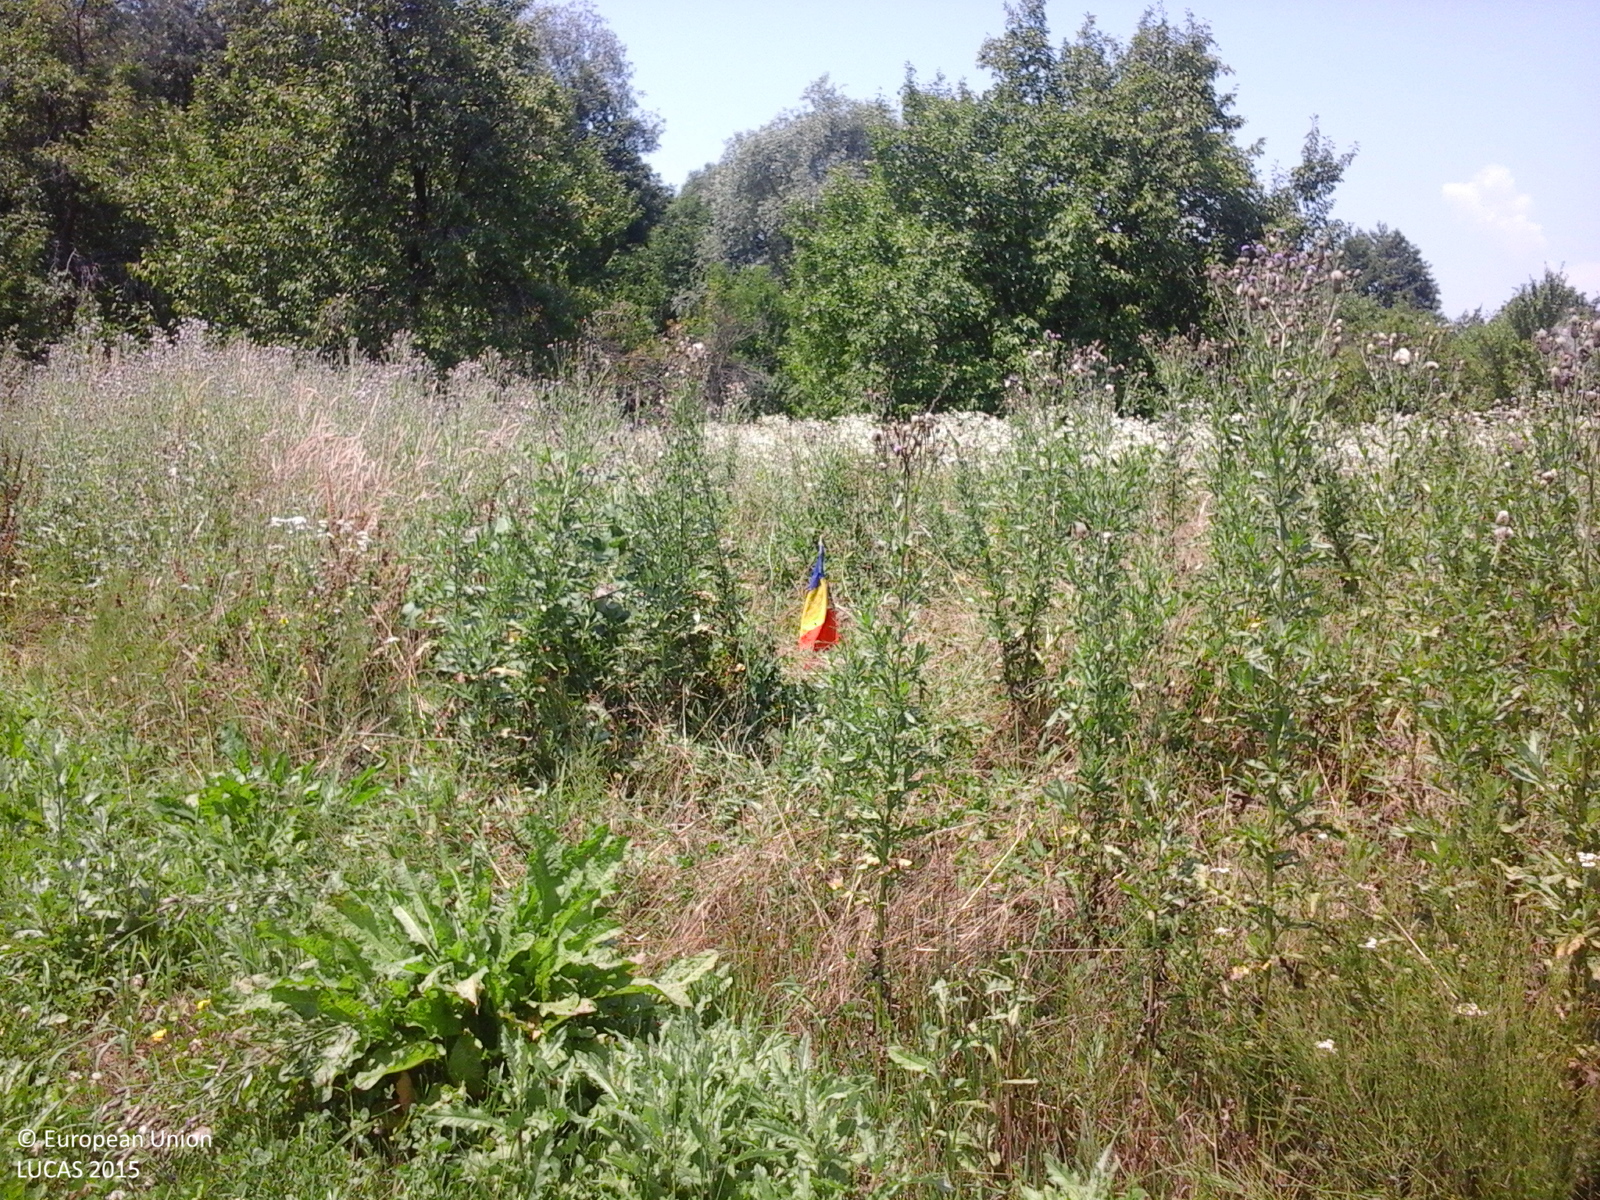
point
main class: Grassland
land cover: Spontaneously vegetated surfaces
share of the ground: > 75 %
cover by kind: herbaceous plants 100 %
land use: Agriculture (excluding fallow land and kitchen gardens)
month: July
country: RO
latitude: 45.0477
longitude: 24.8747
